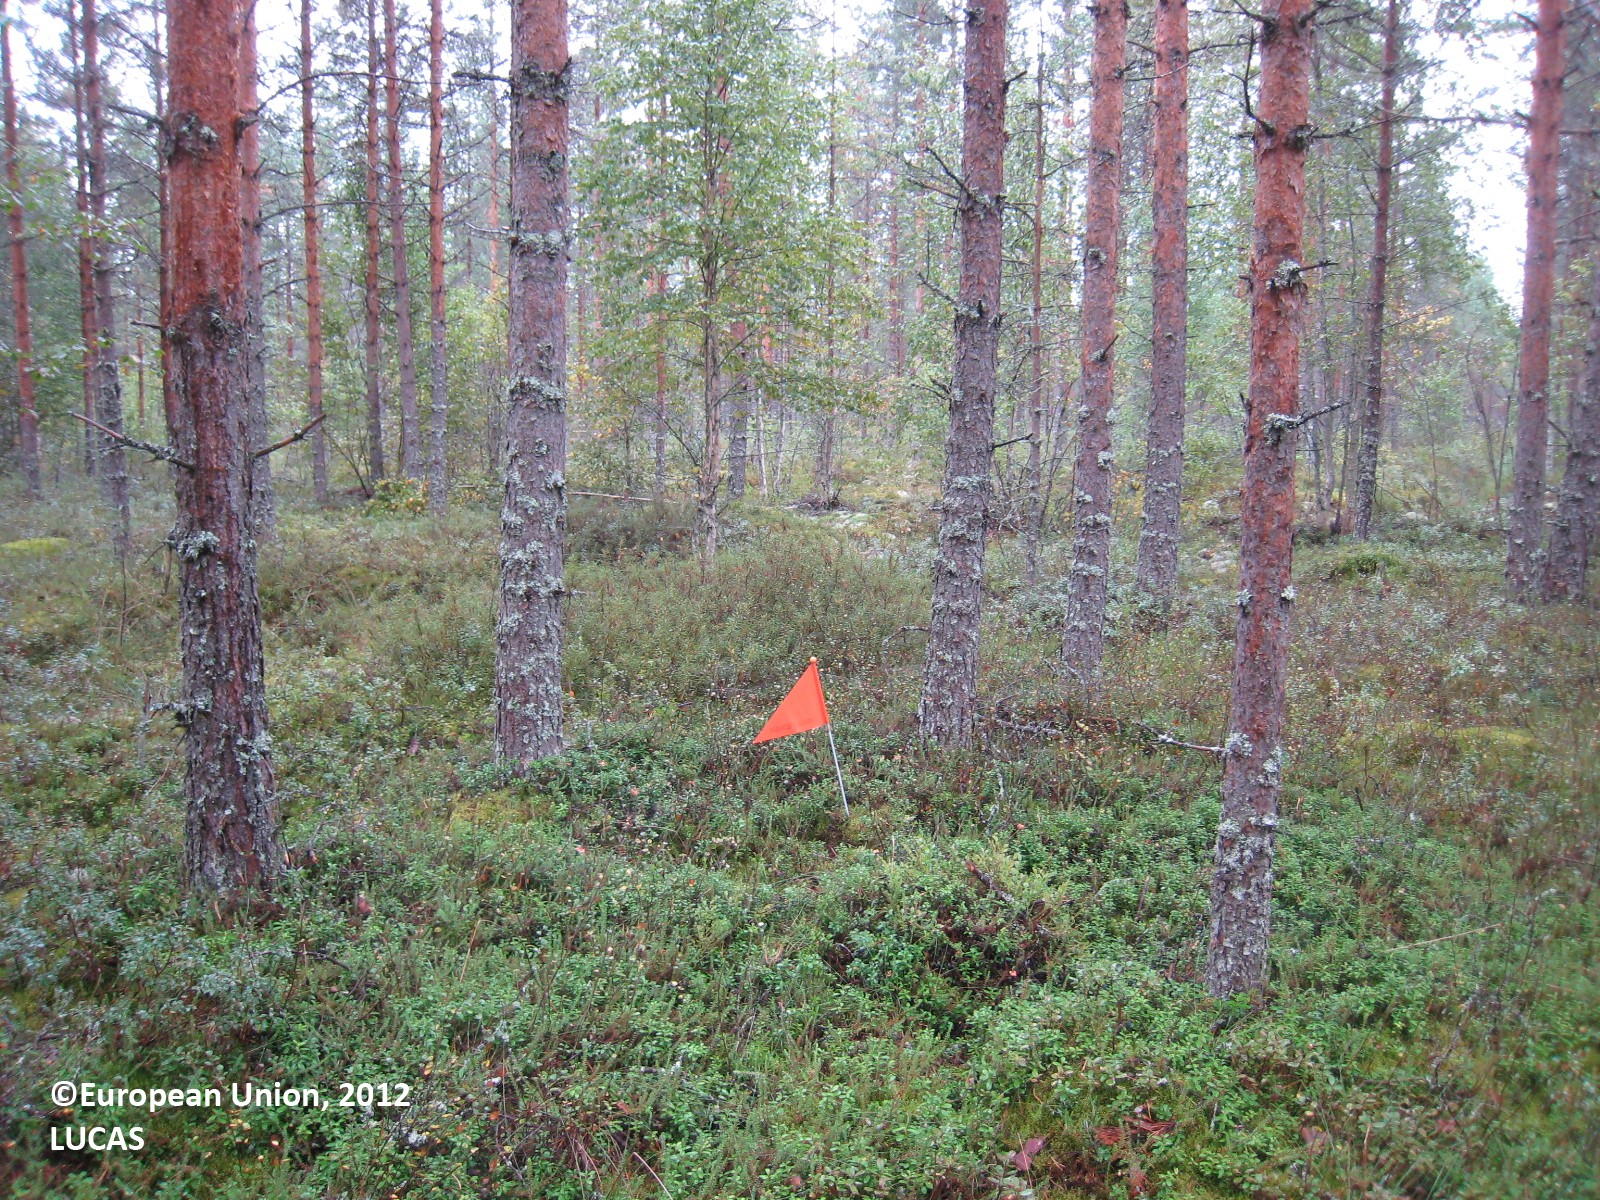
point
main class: Woodland
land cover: Pine dominated coniferous woodland
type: mire and swamp forests
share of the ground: 50 - 75 %
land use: Forestry
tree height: > 5 m
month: August
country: FI
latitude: 61.9083
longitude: 26.2218
